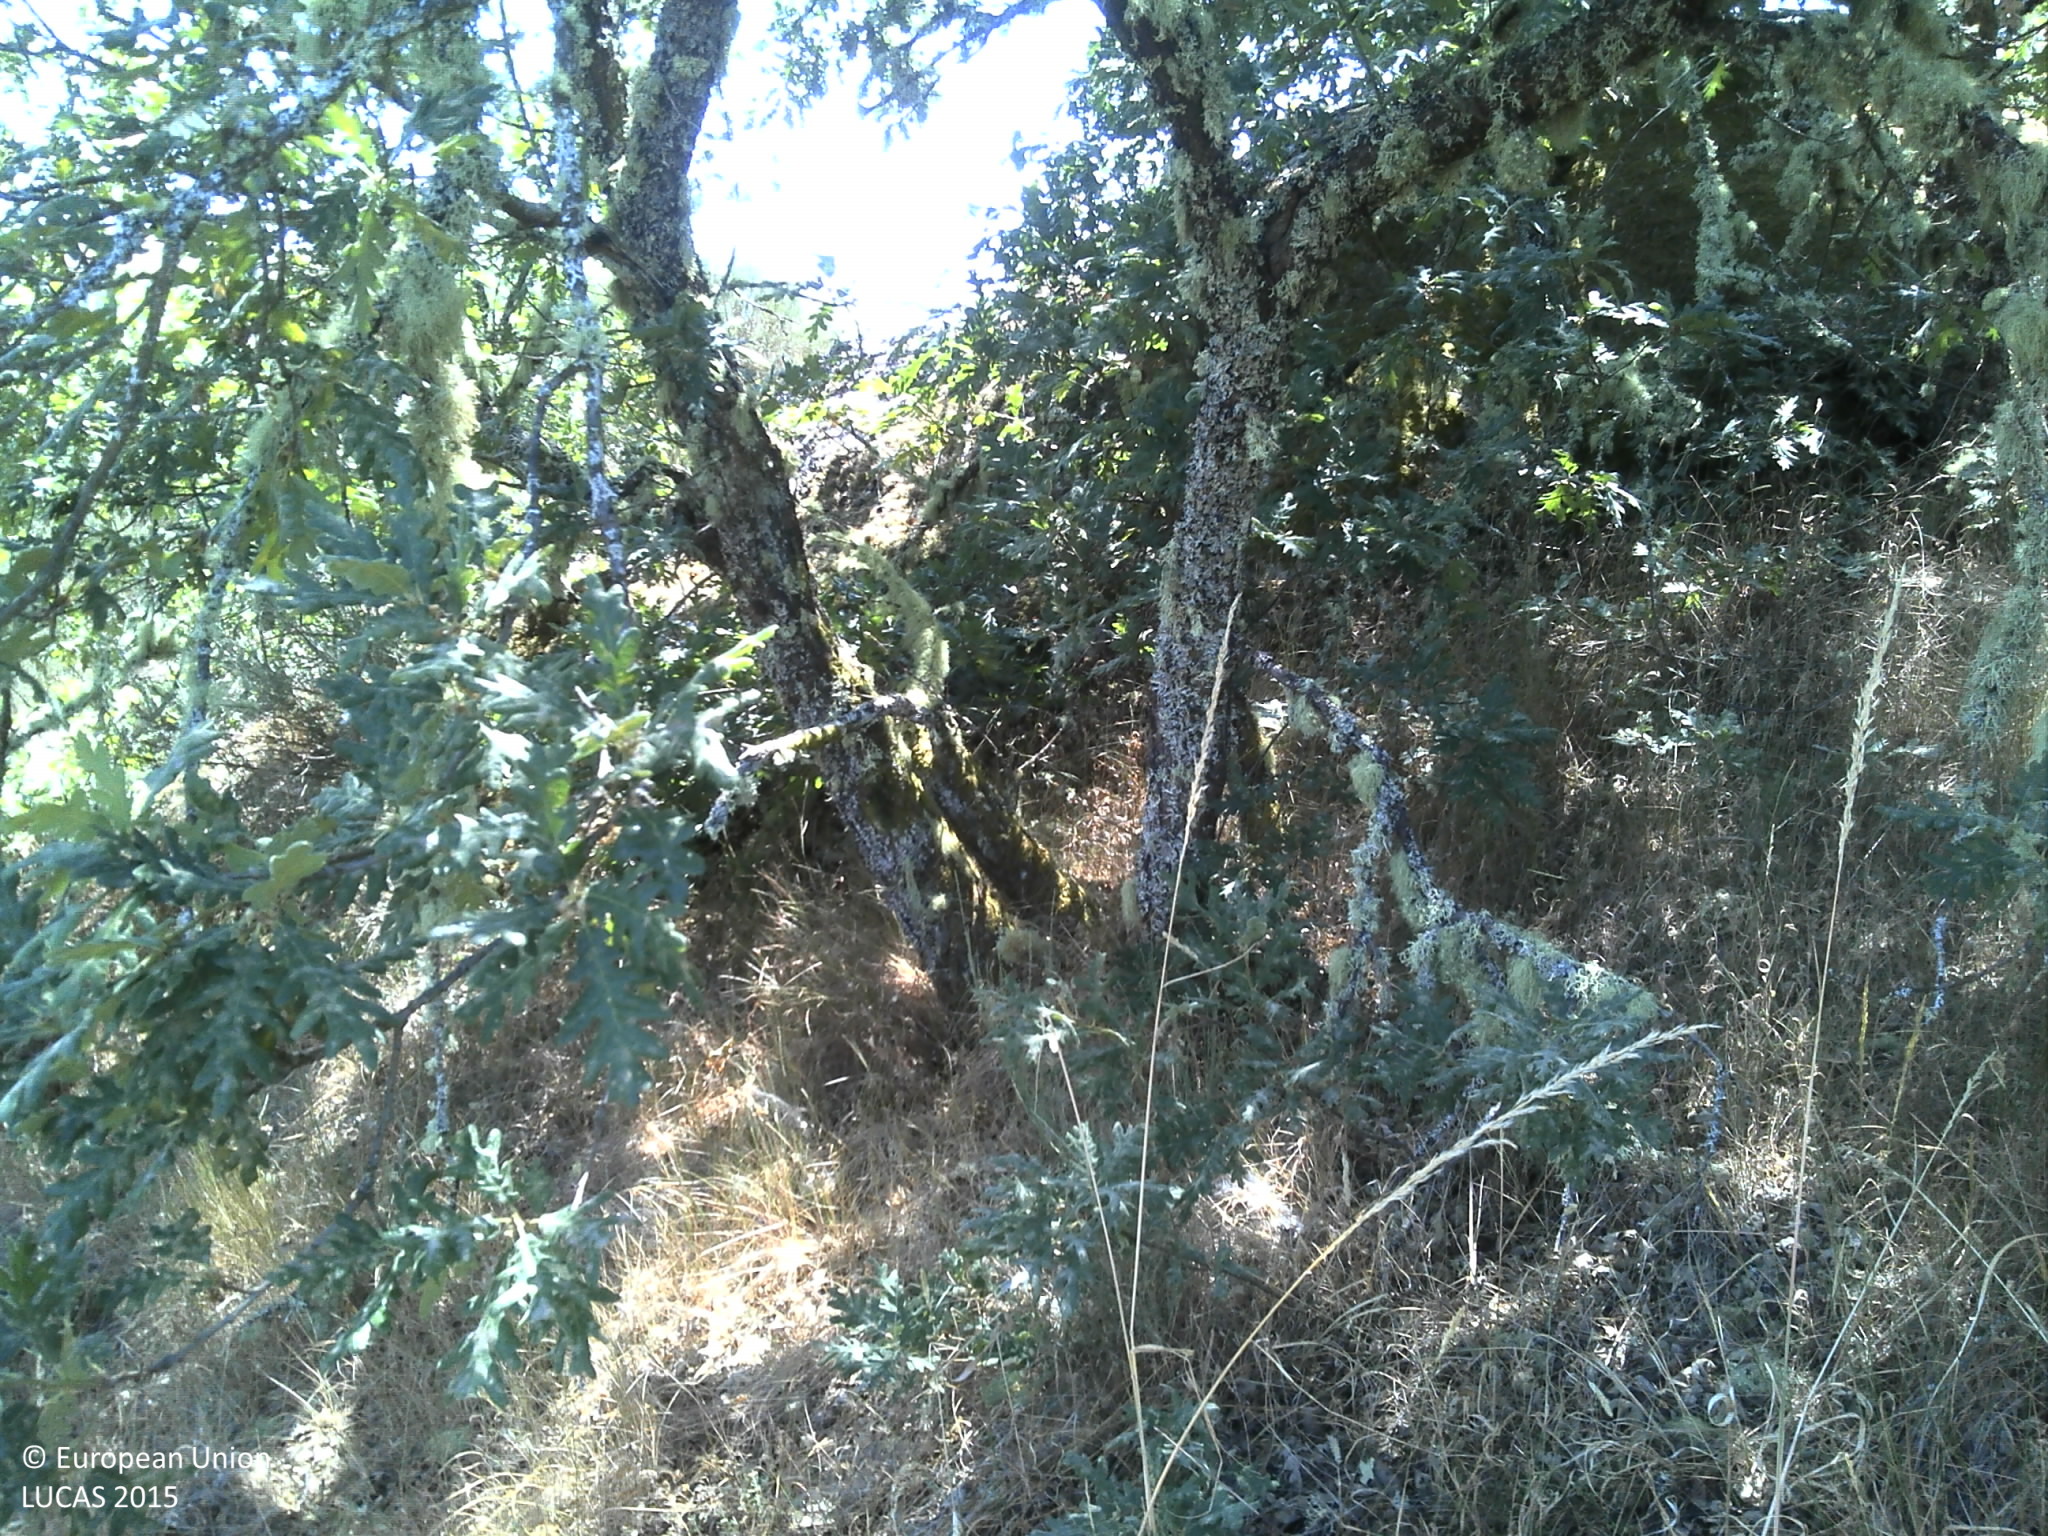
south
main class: Shrubland
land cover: Shrubland without tree cover
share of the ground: > 75 %
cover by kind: shrubs 90 %, herbaceous plants 5 %, unconsolidated bare surface 5 %
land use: Semi-natural and natural areas not in use
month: July
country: PT
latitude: 41.7835
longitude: -7.7905
